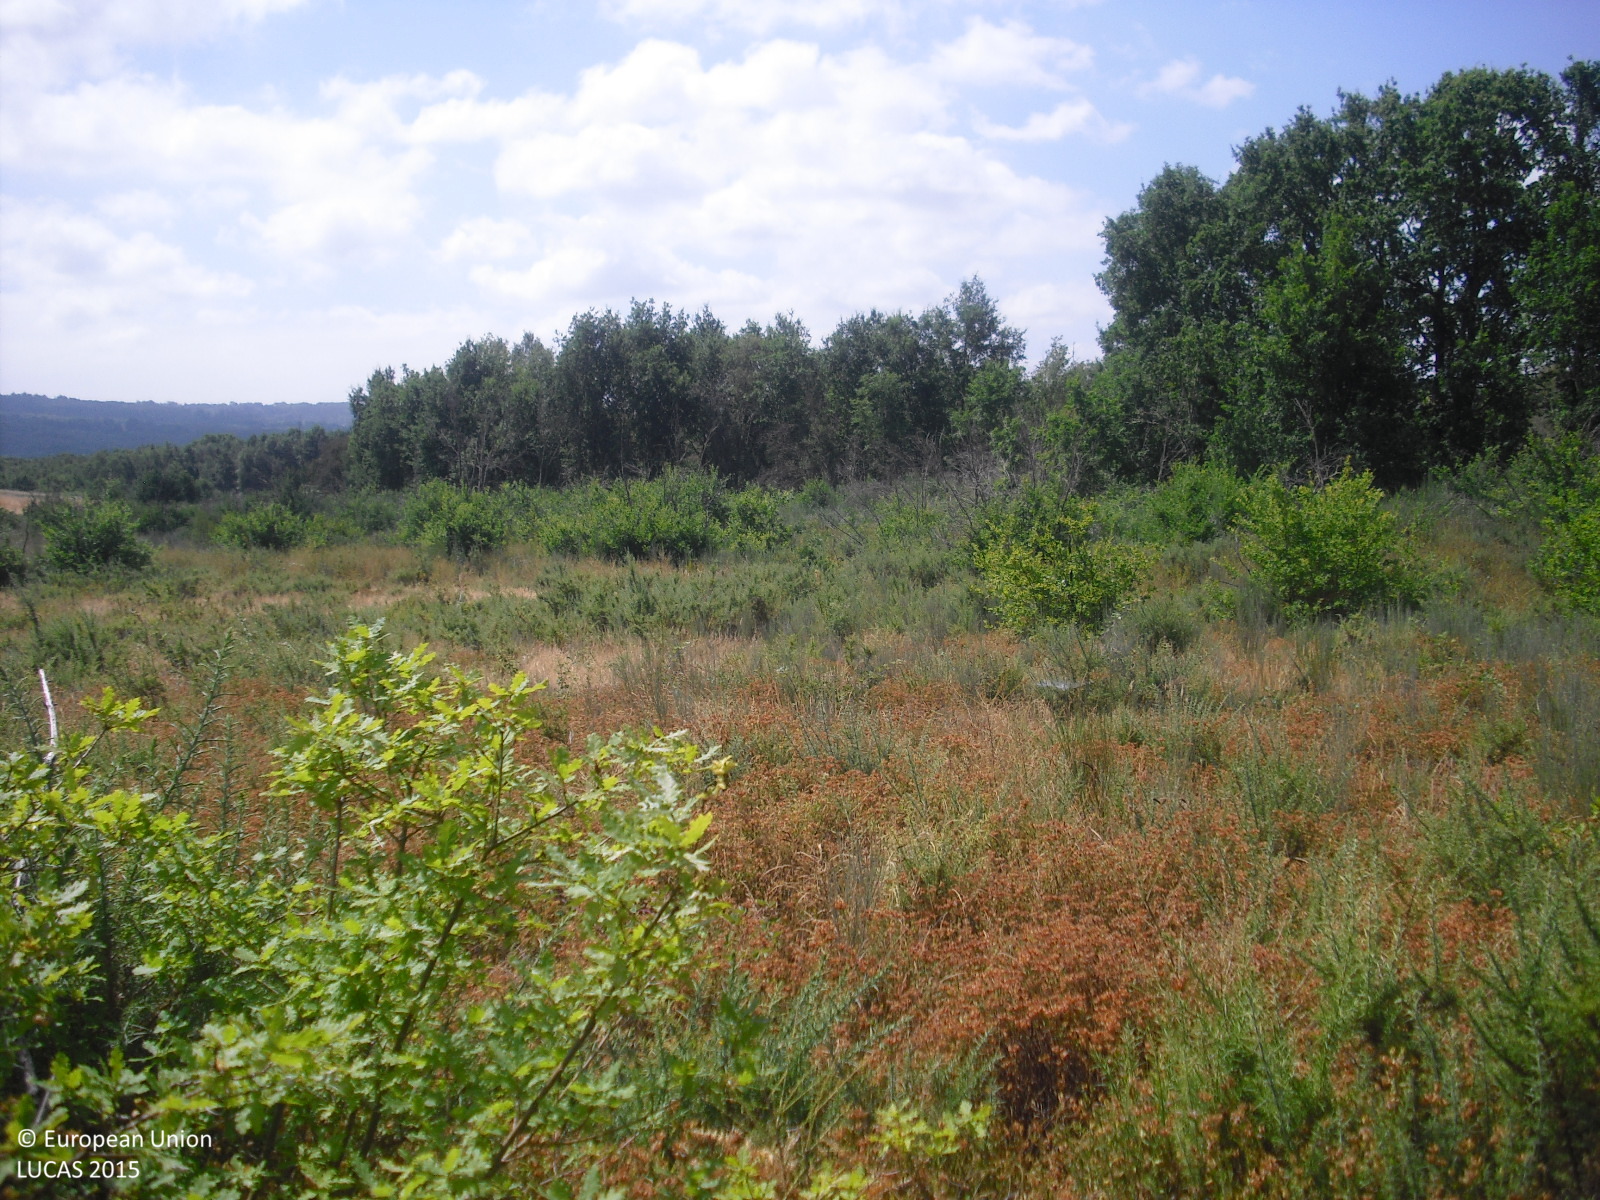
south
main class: Shrubland
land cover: Shrubland with sparse tree cover
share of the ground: > 75 %
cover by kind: shrubs 80 %, herbaceous plants 15 %, broadleaved forest trees 5 %
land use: Abandoned areas
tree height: < 5 m
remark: Burnt area
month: July
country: ES
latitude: 42.3600
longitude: -7.7647
